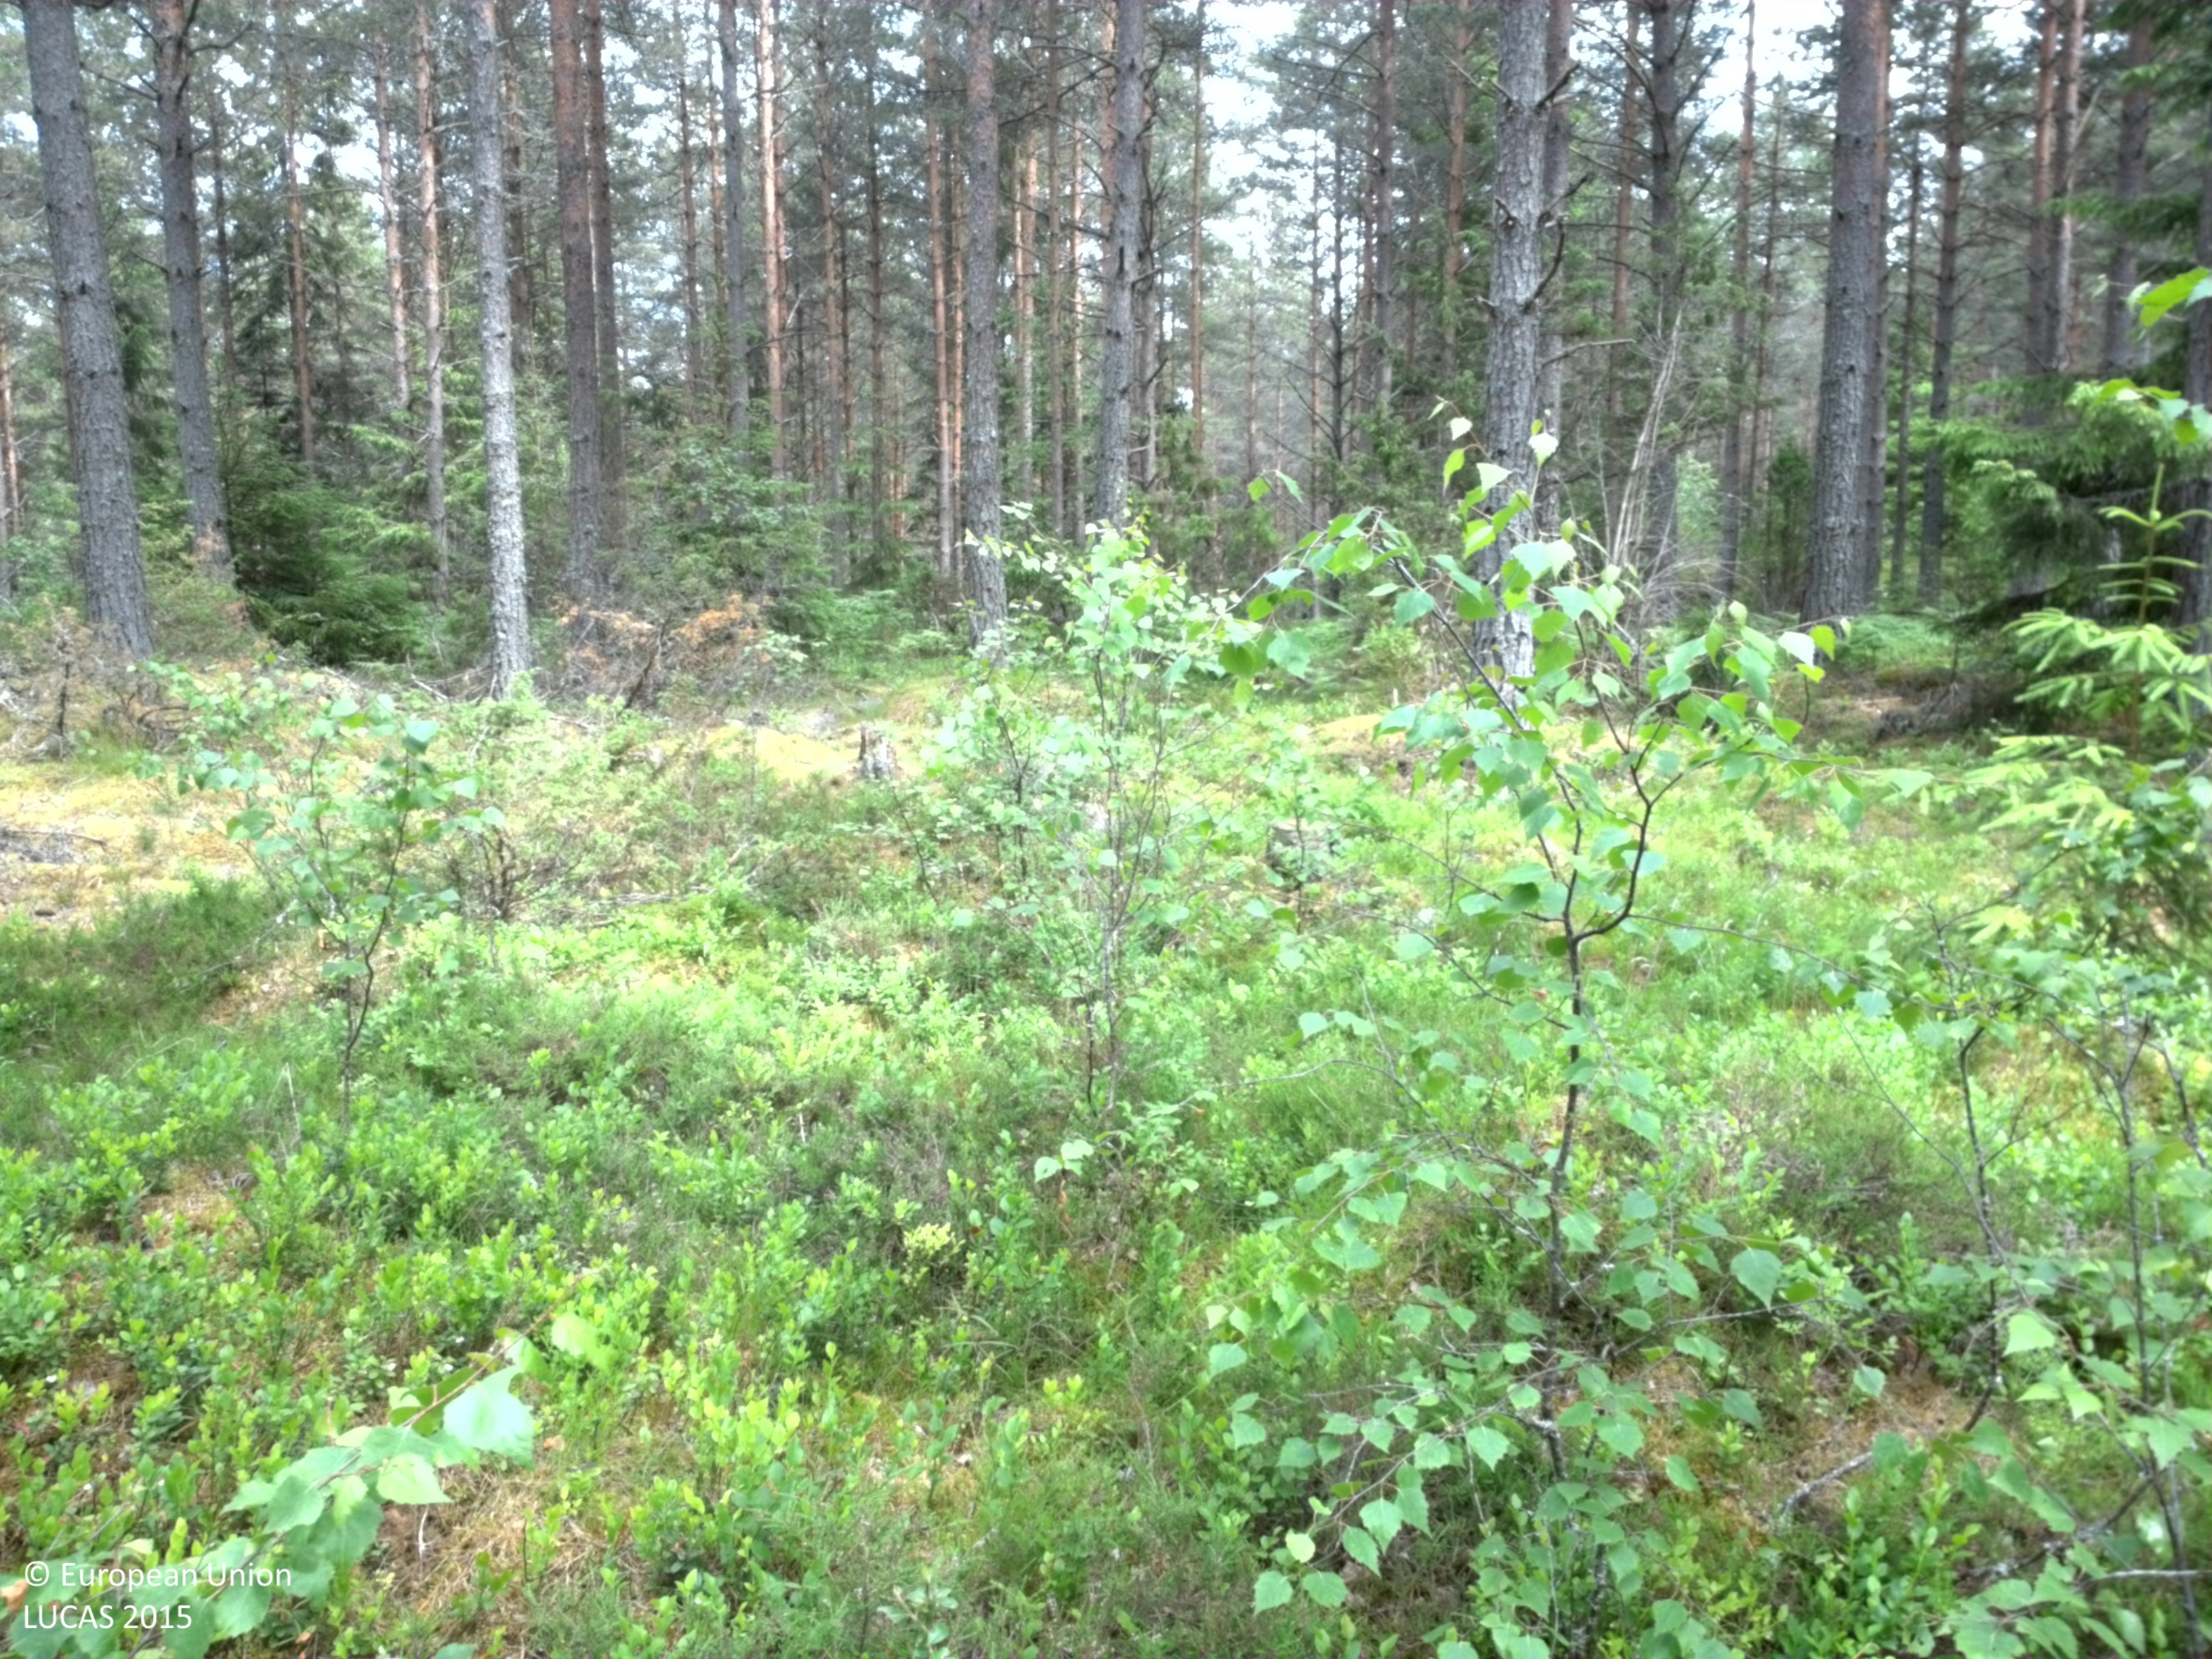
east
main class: Woodland
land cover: Pine dominated coniferous woodland
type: boreal forest
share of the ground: 10 - 25 %
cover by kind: herbaceous plants 35 %, lichens and mosses 35 %, coniferous forest trees 20 %, broadleaved forest trees 5 %, shrubs 5 %
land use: Forestry
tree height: > 5 m
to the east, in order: Pine dominated coniferous woodland; Spruce dominated coniferous woodland
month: June
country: SE
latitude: 58.7008
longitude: 15.5334
